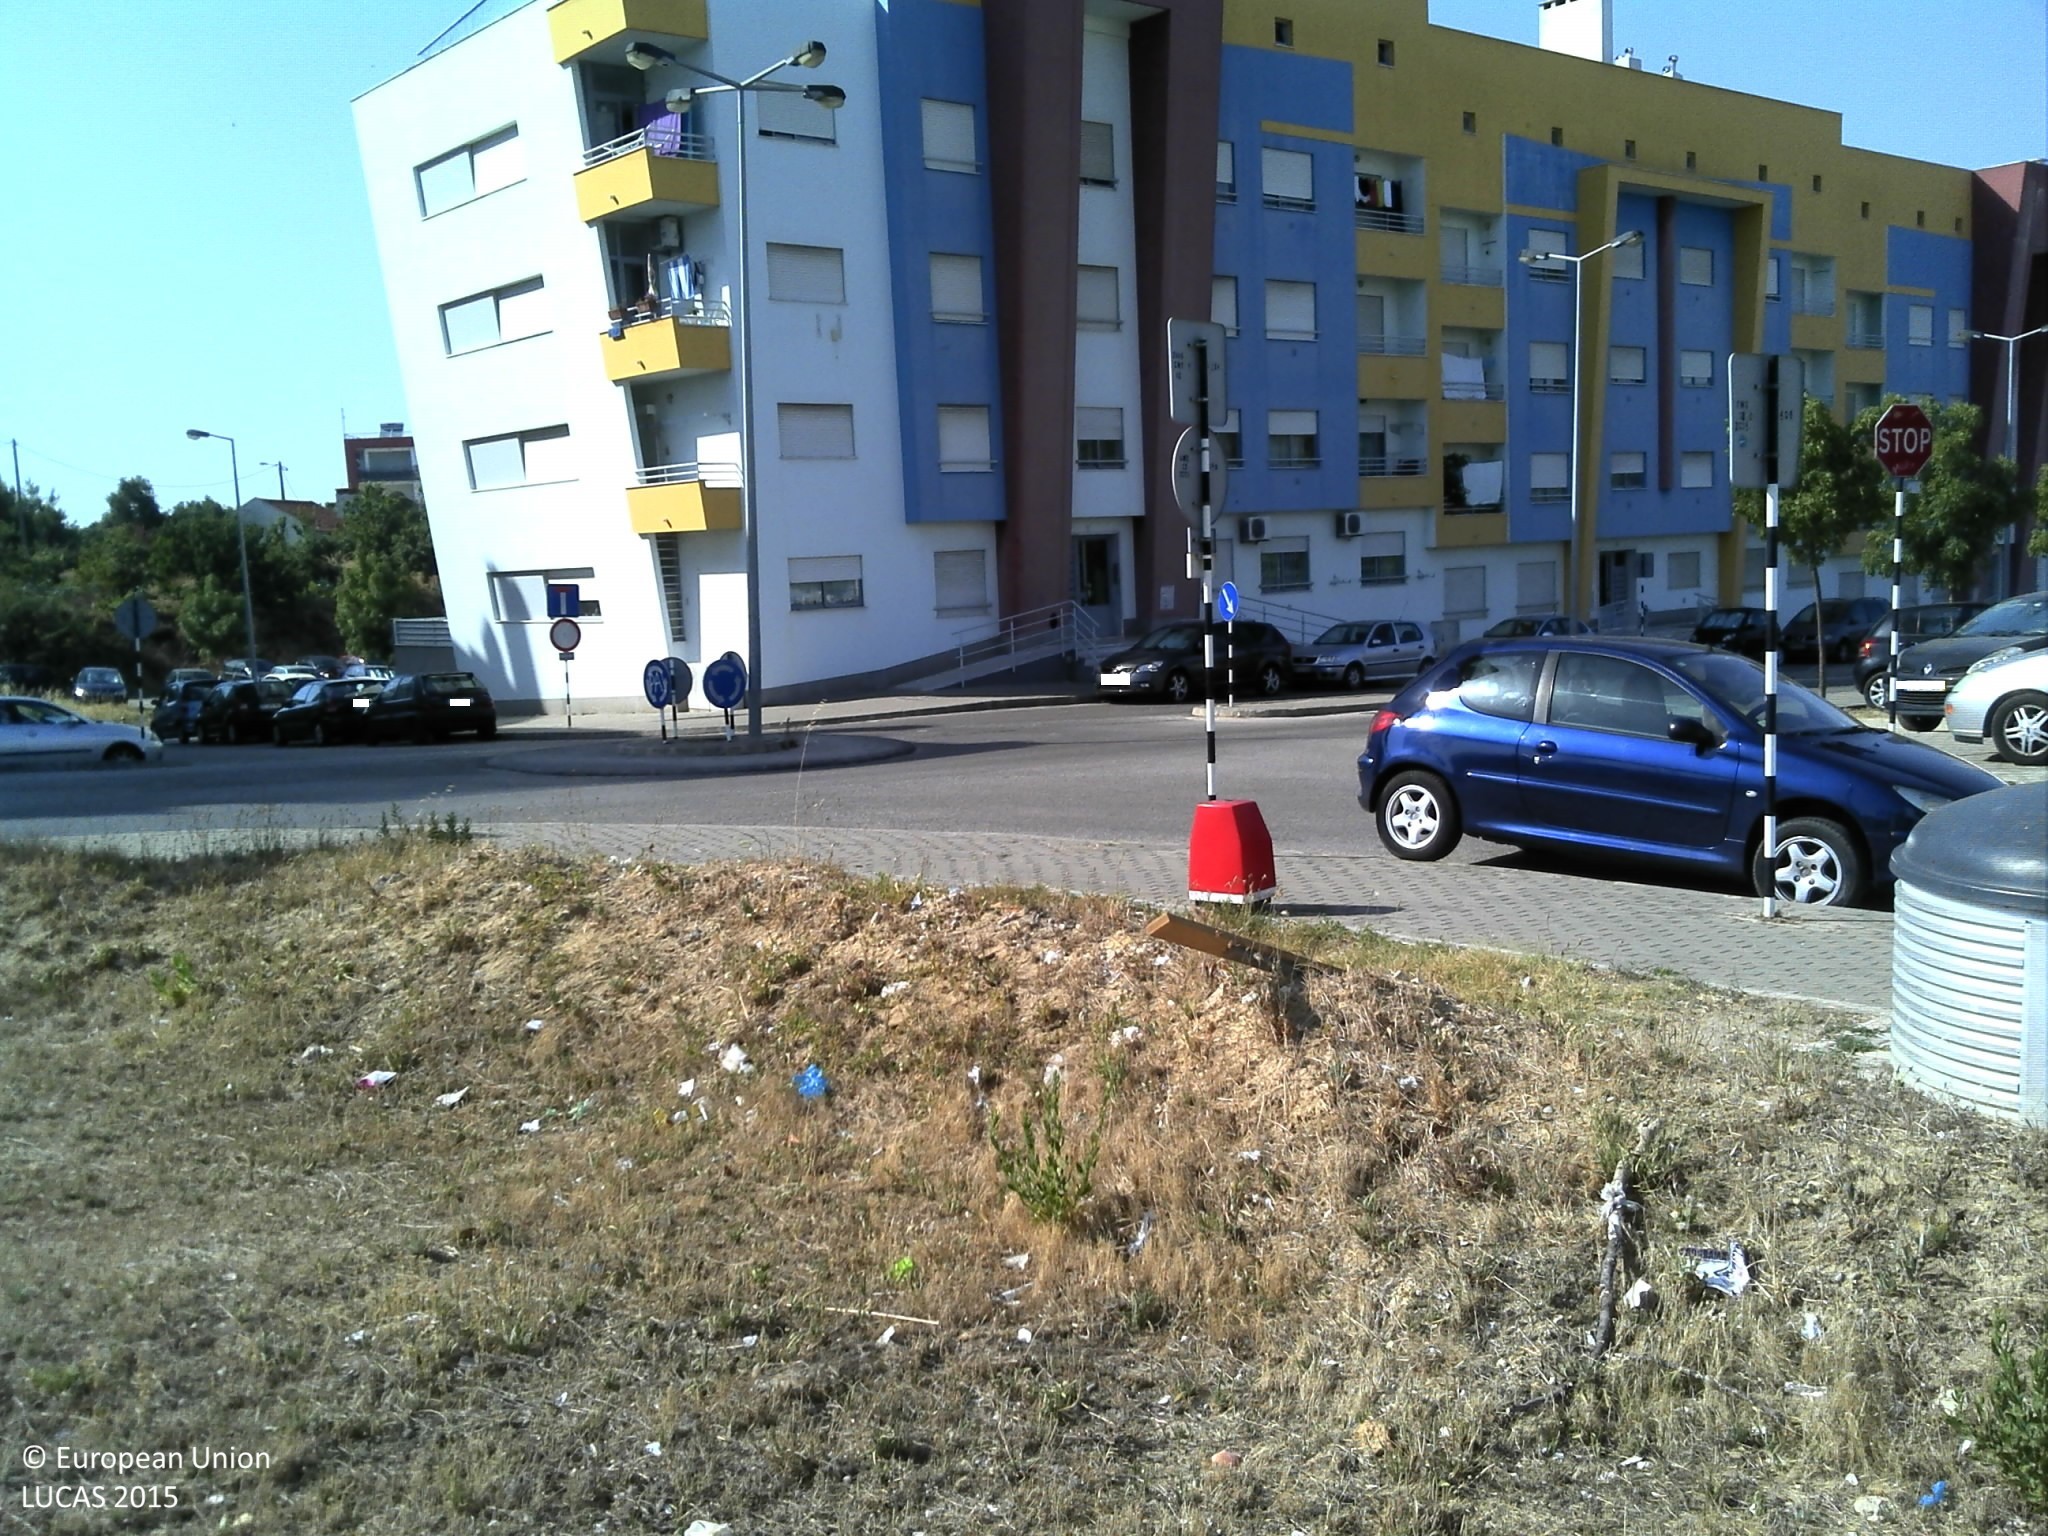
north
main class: Grassland
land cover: Grassland with sparse tree/shrub cover
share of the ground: 25 - 50 %
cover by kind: herbaceous plants 40 %, unconsolidated bare surface 35 %, broadleaved forest trees 5 %
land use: Residential
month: June
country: PT
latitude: 38.6117
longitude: -9.1011
